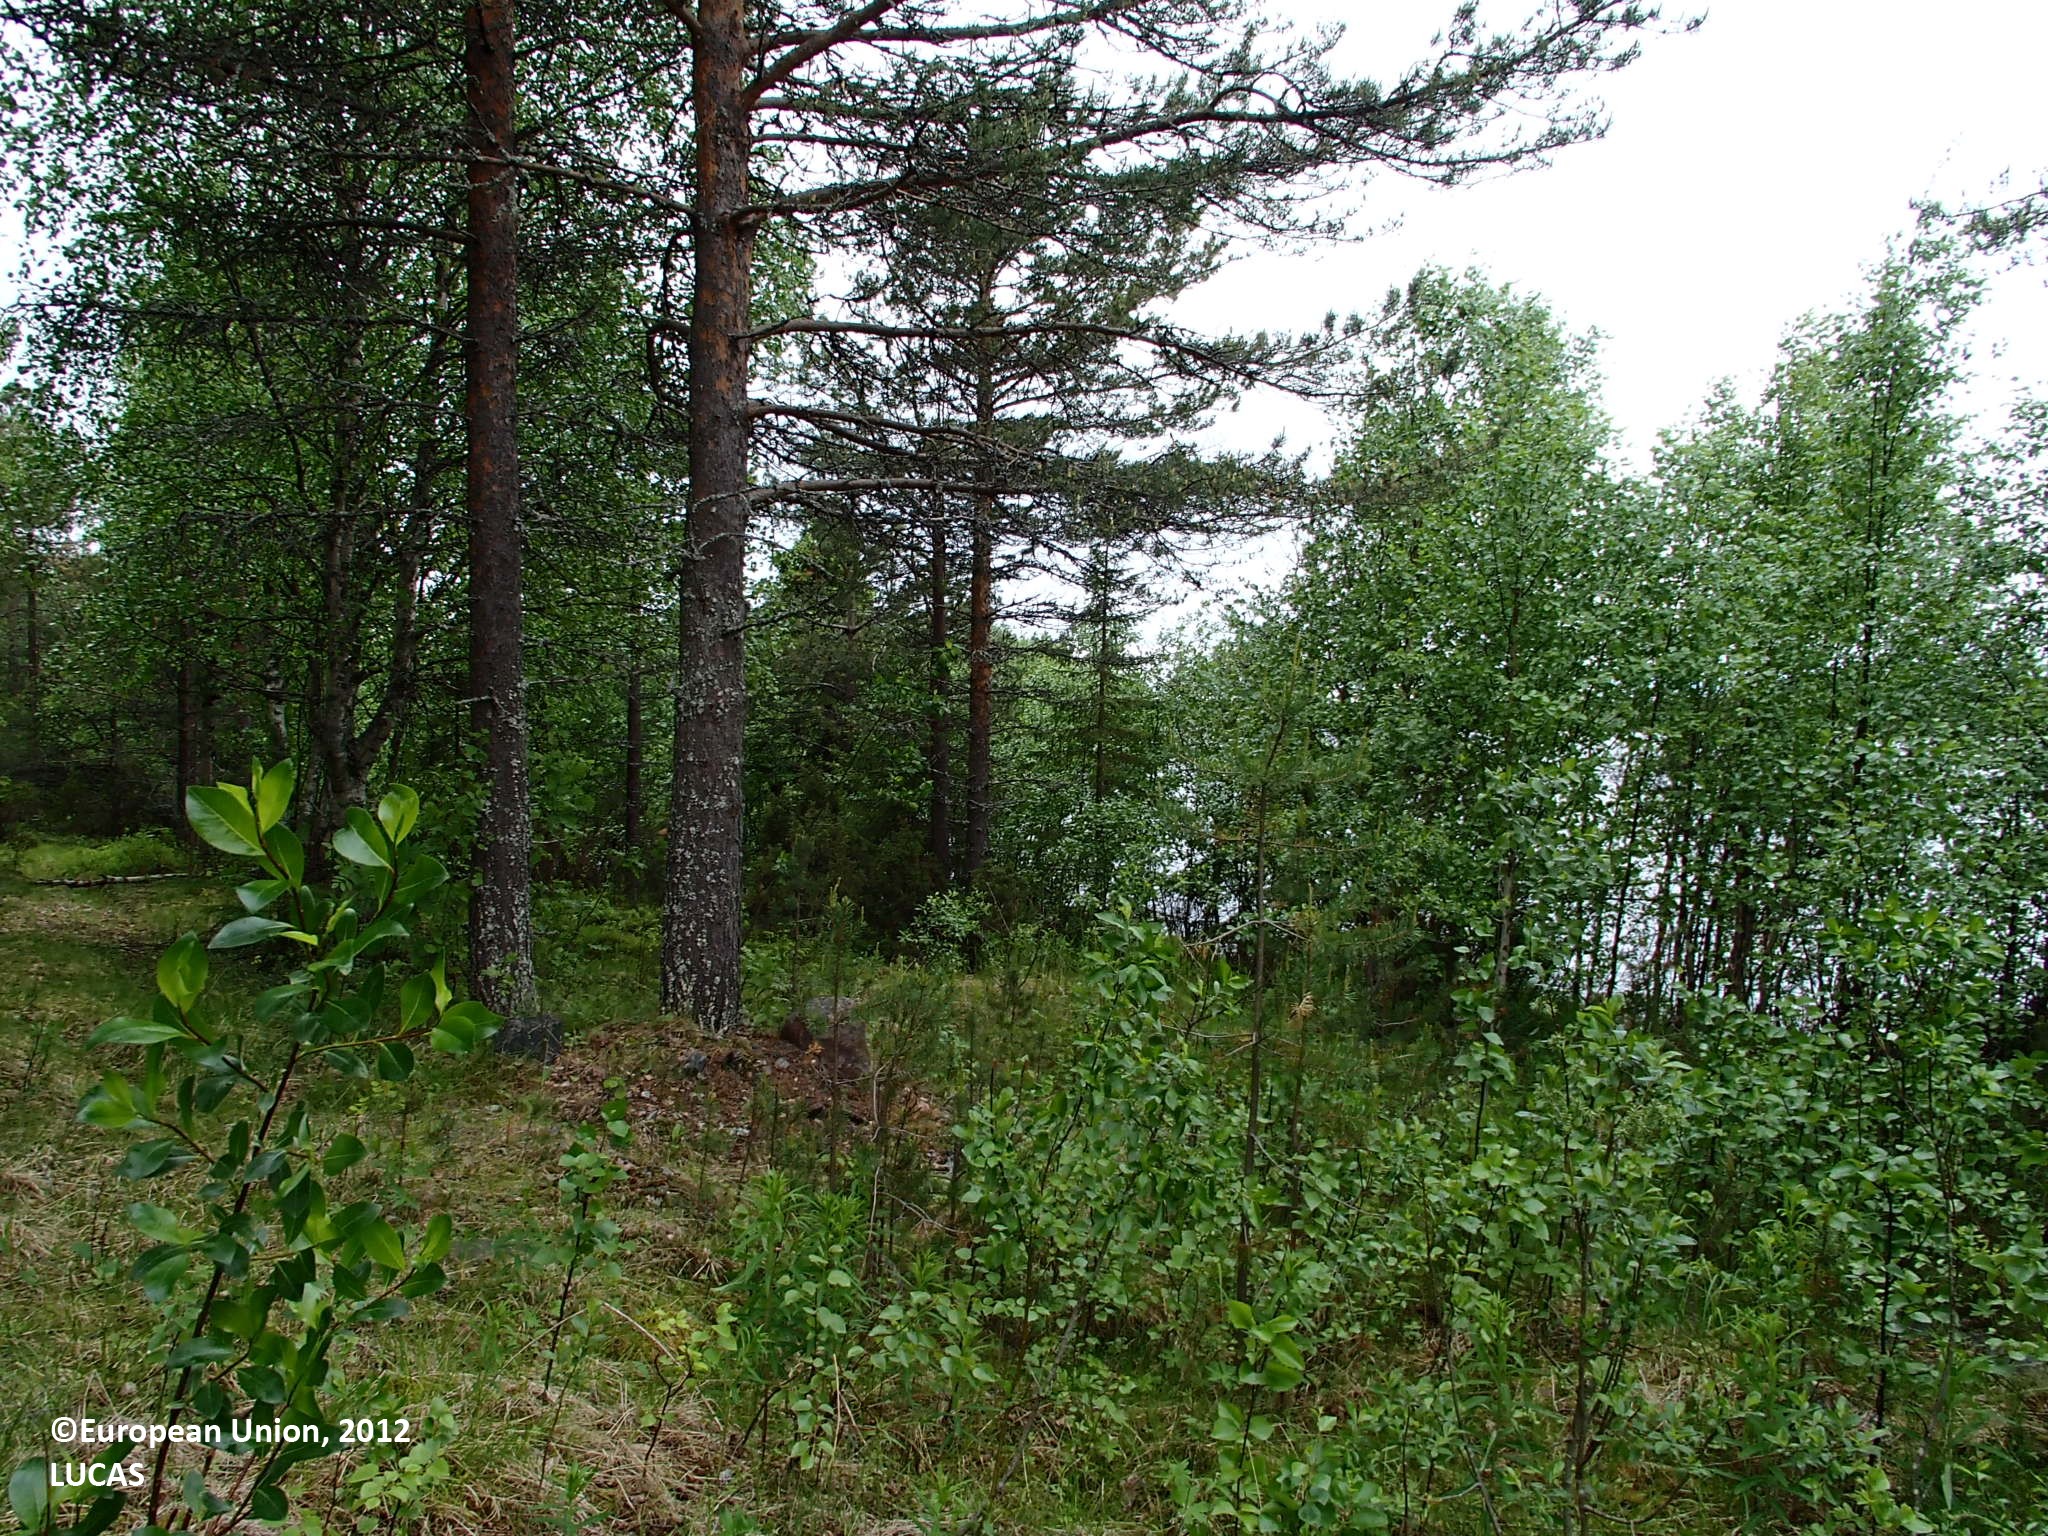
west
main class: Woodland
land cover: Broadleaved woodland
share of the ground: 25 - 50 %
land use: Forestry
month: June
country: FI
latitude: 66.4736
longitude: 27.2828
